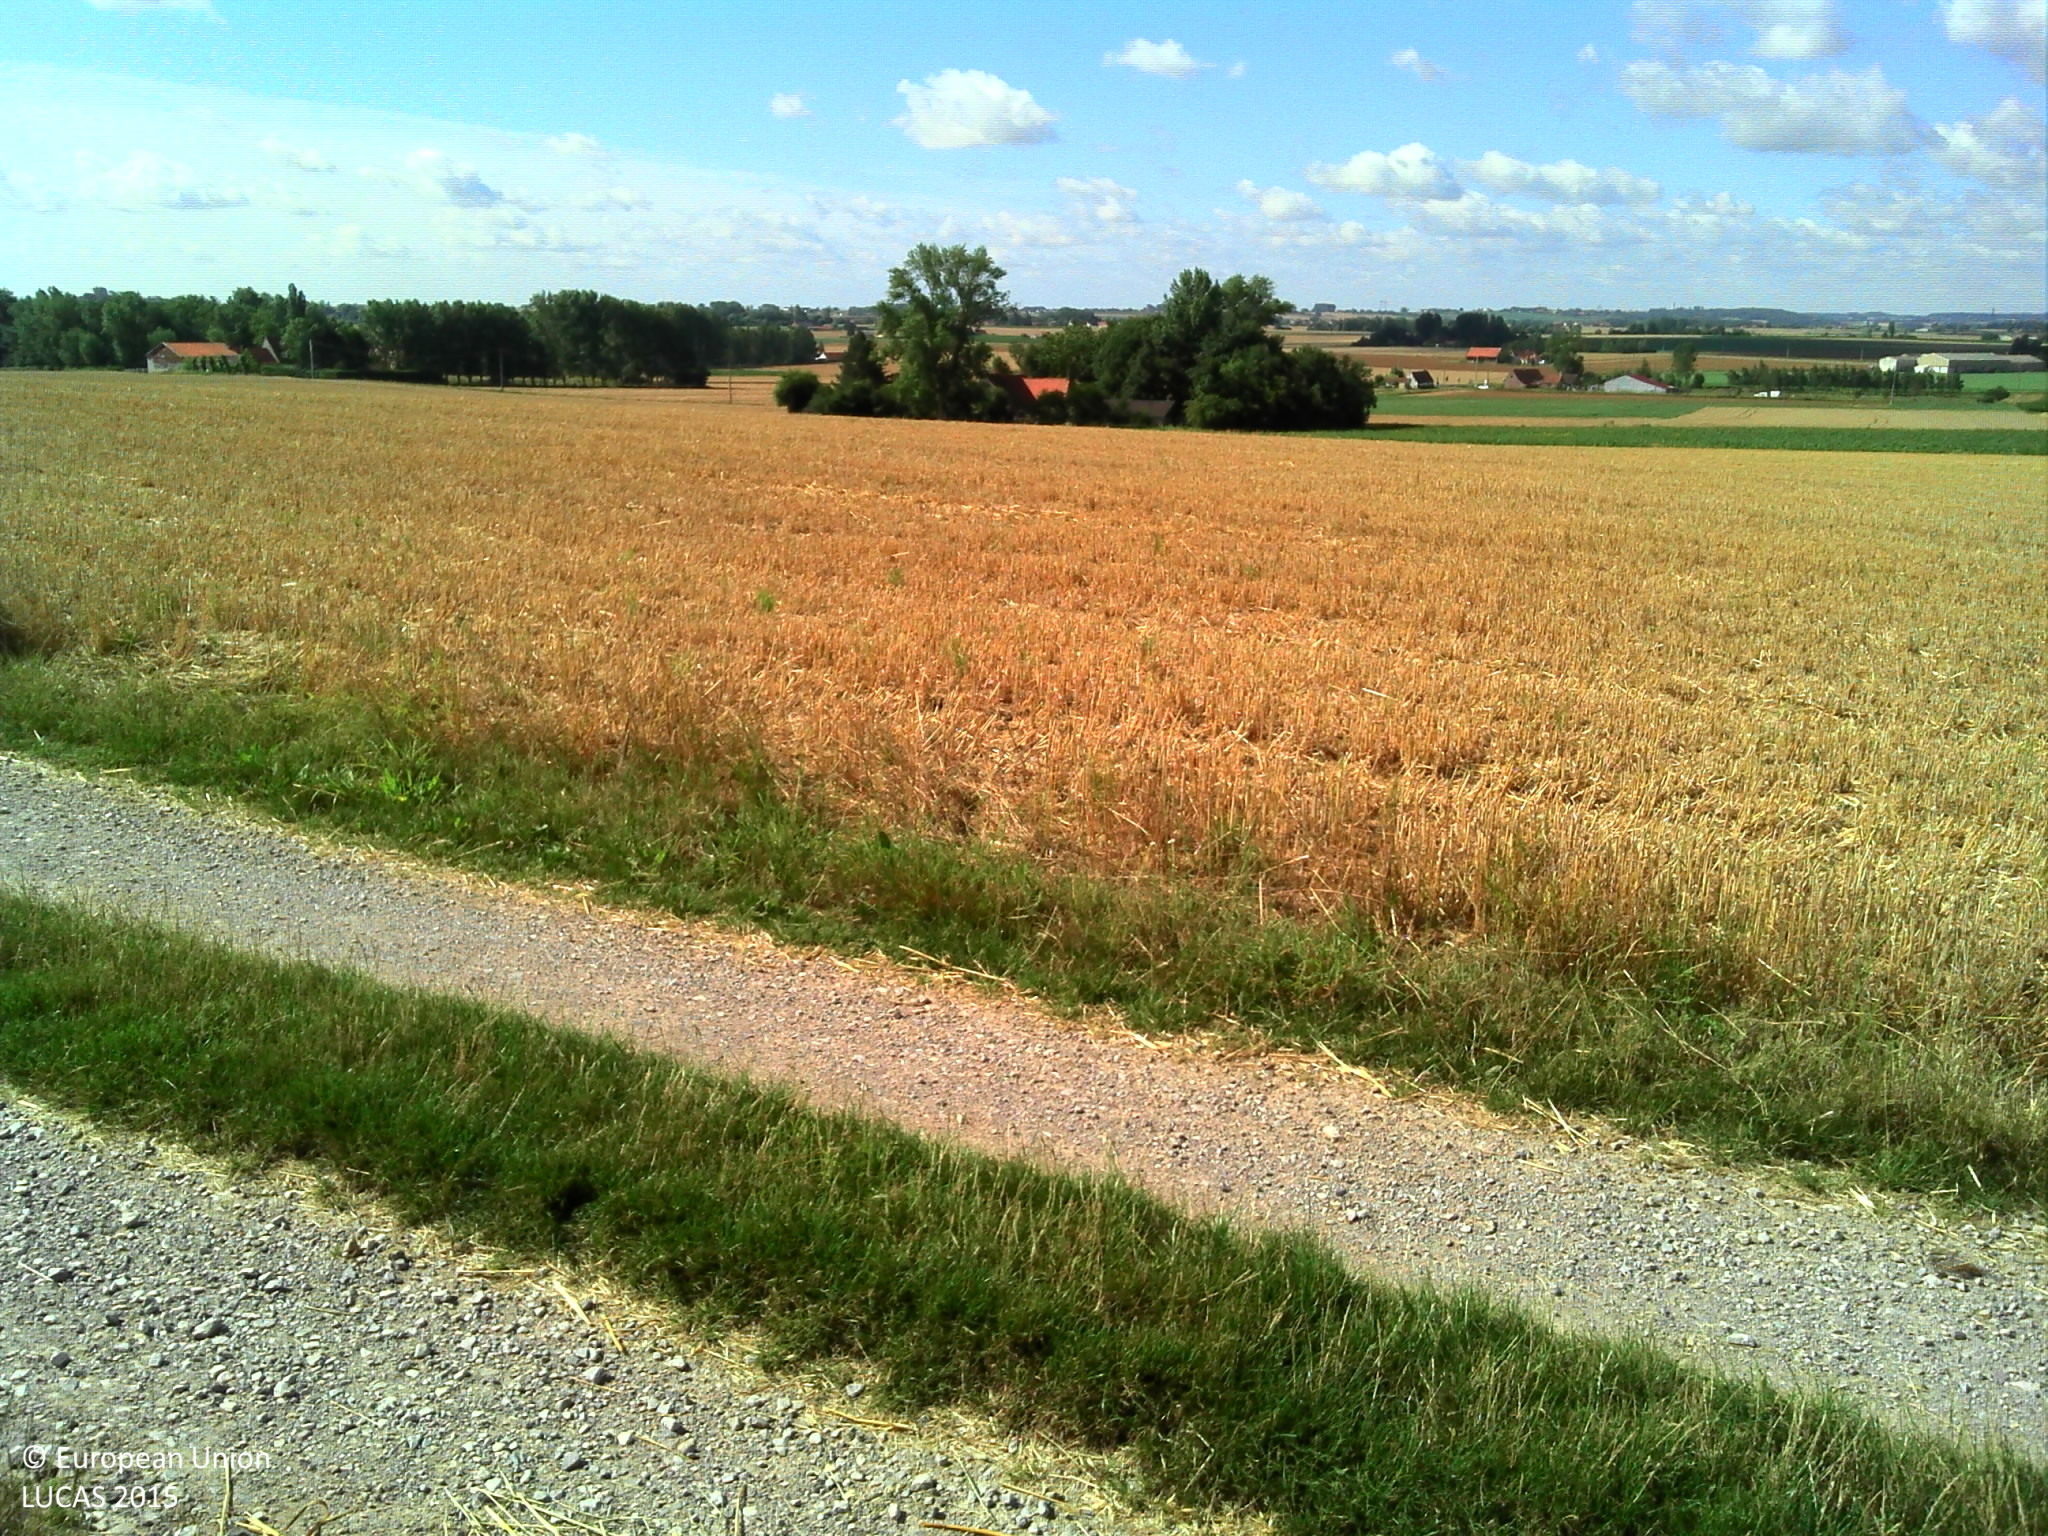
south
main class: Cropland
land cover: Rape and turnip rape
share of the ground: > 75 %
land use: Agriculture (excluding fallow land and kitchen gardens)
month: July
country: FR
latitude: 50.9203
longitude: 2.3473
